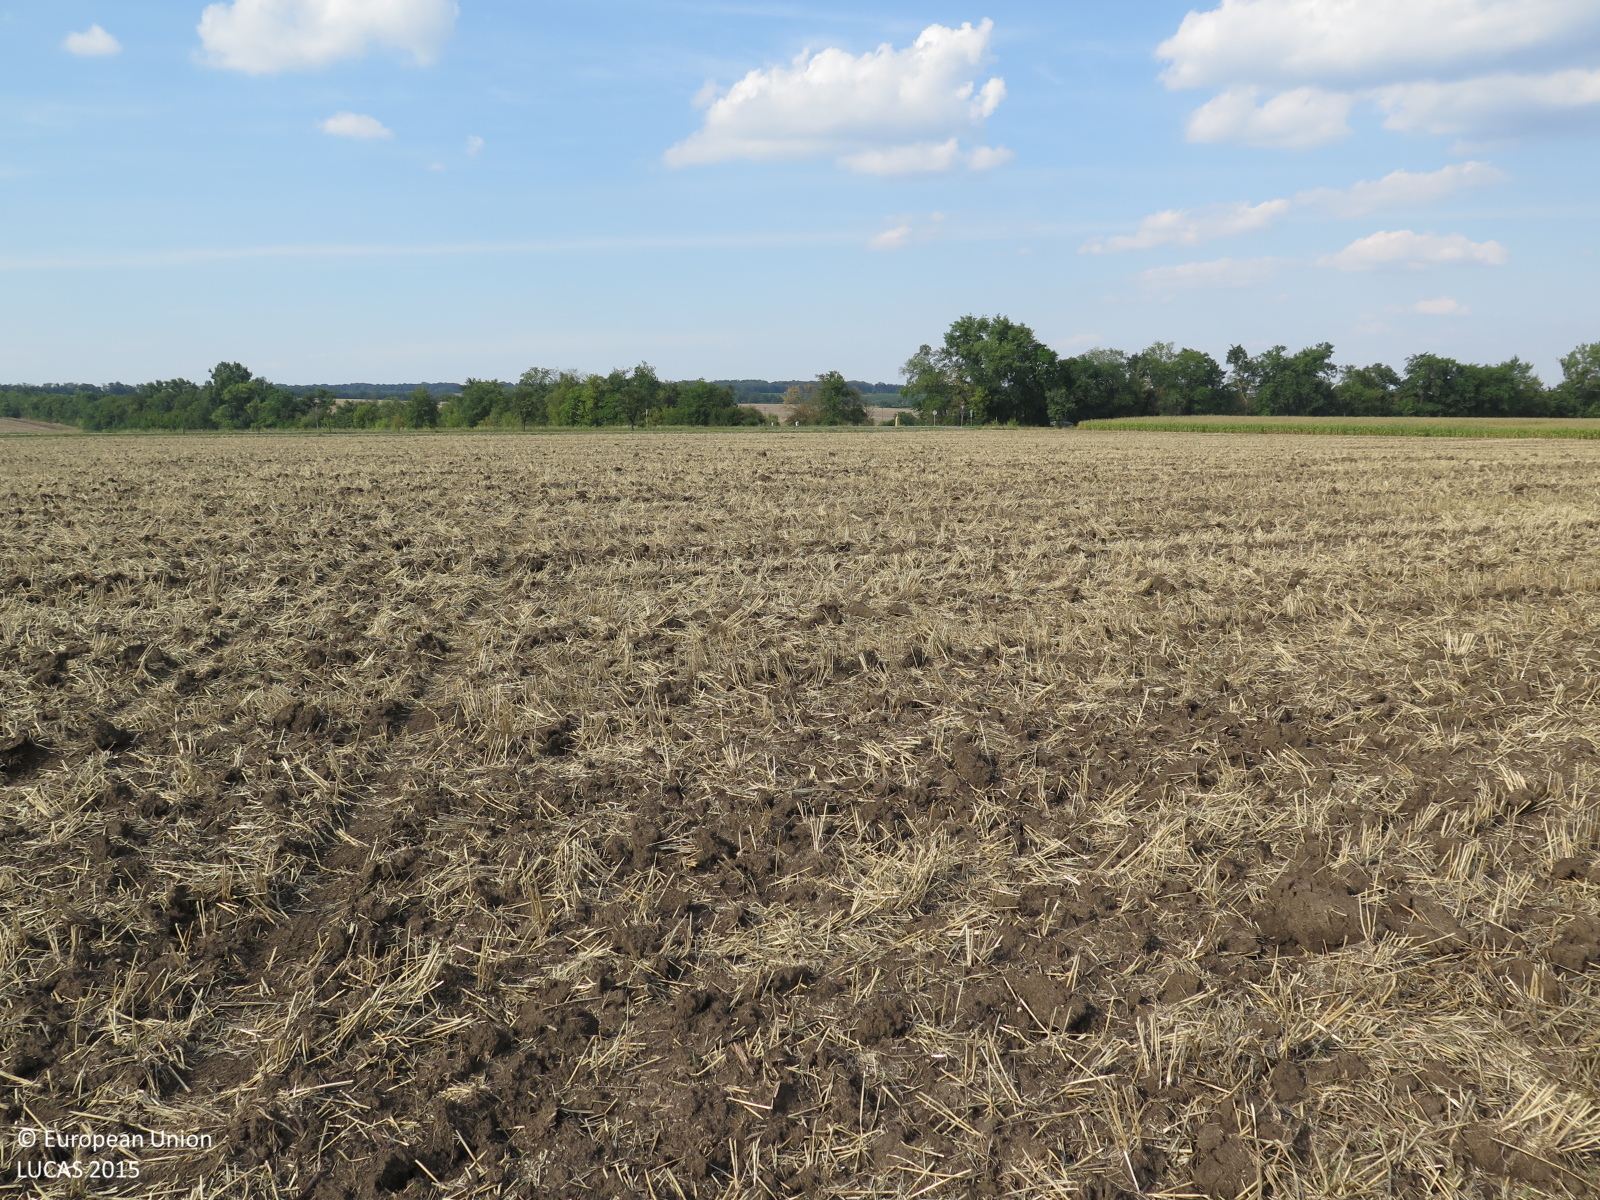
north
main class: Cropland
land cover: Common wheat
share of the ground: 25 - 50 %
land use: Agriculture (excluding fallow land and kitchen gardens)
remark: Harvested field
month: August
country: CZ
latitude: 48.8318
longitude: 16.9972
